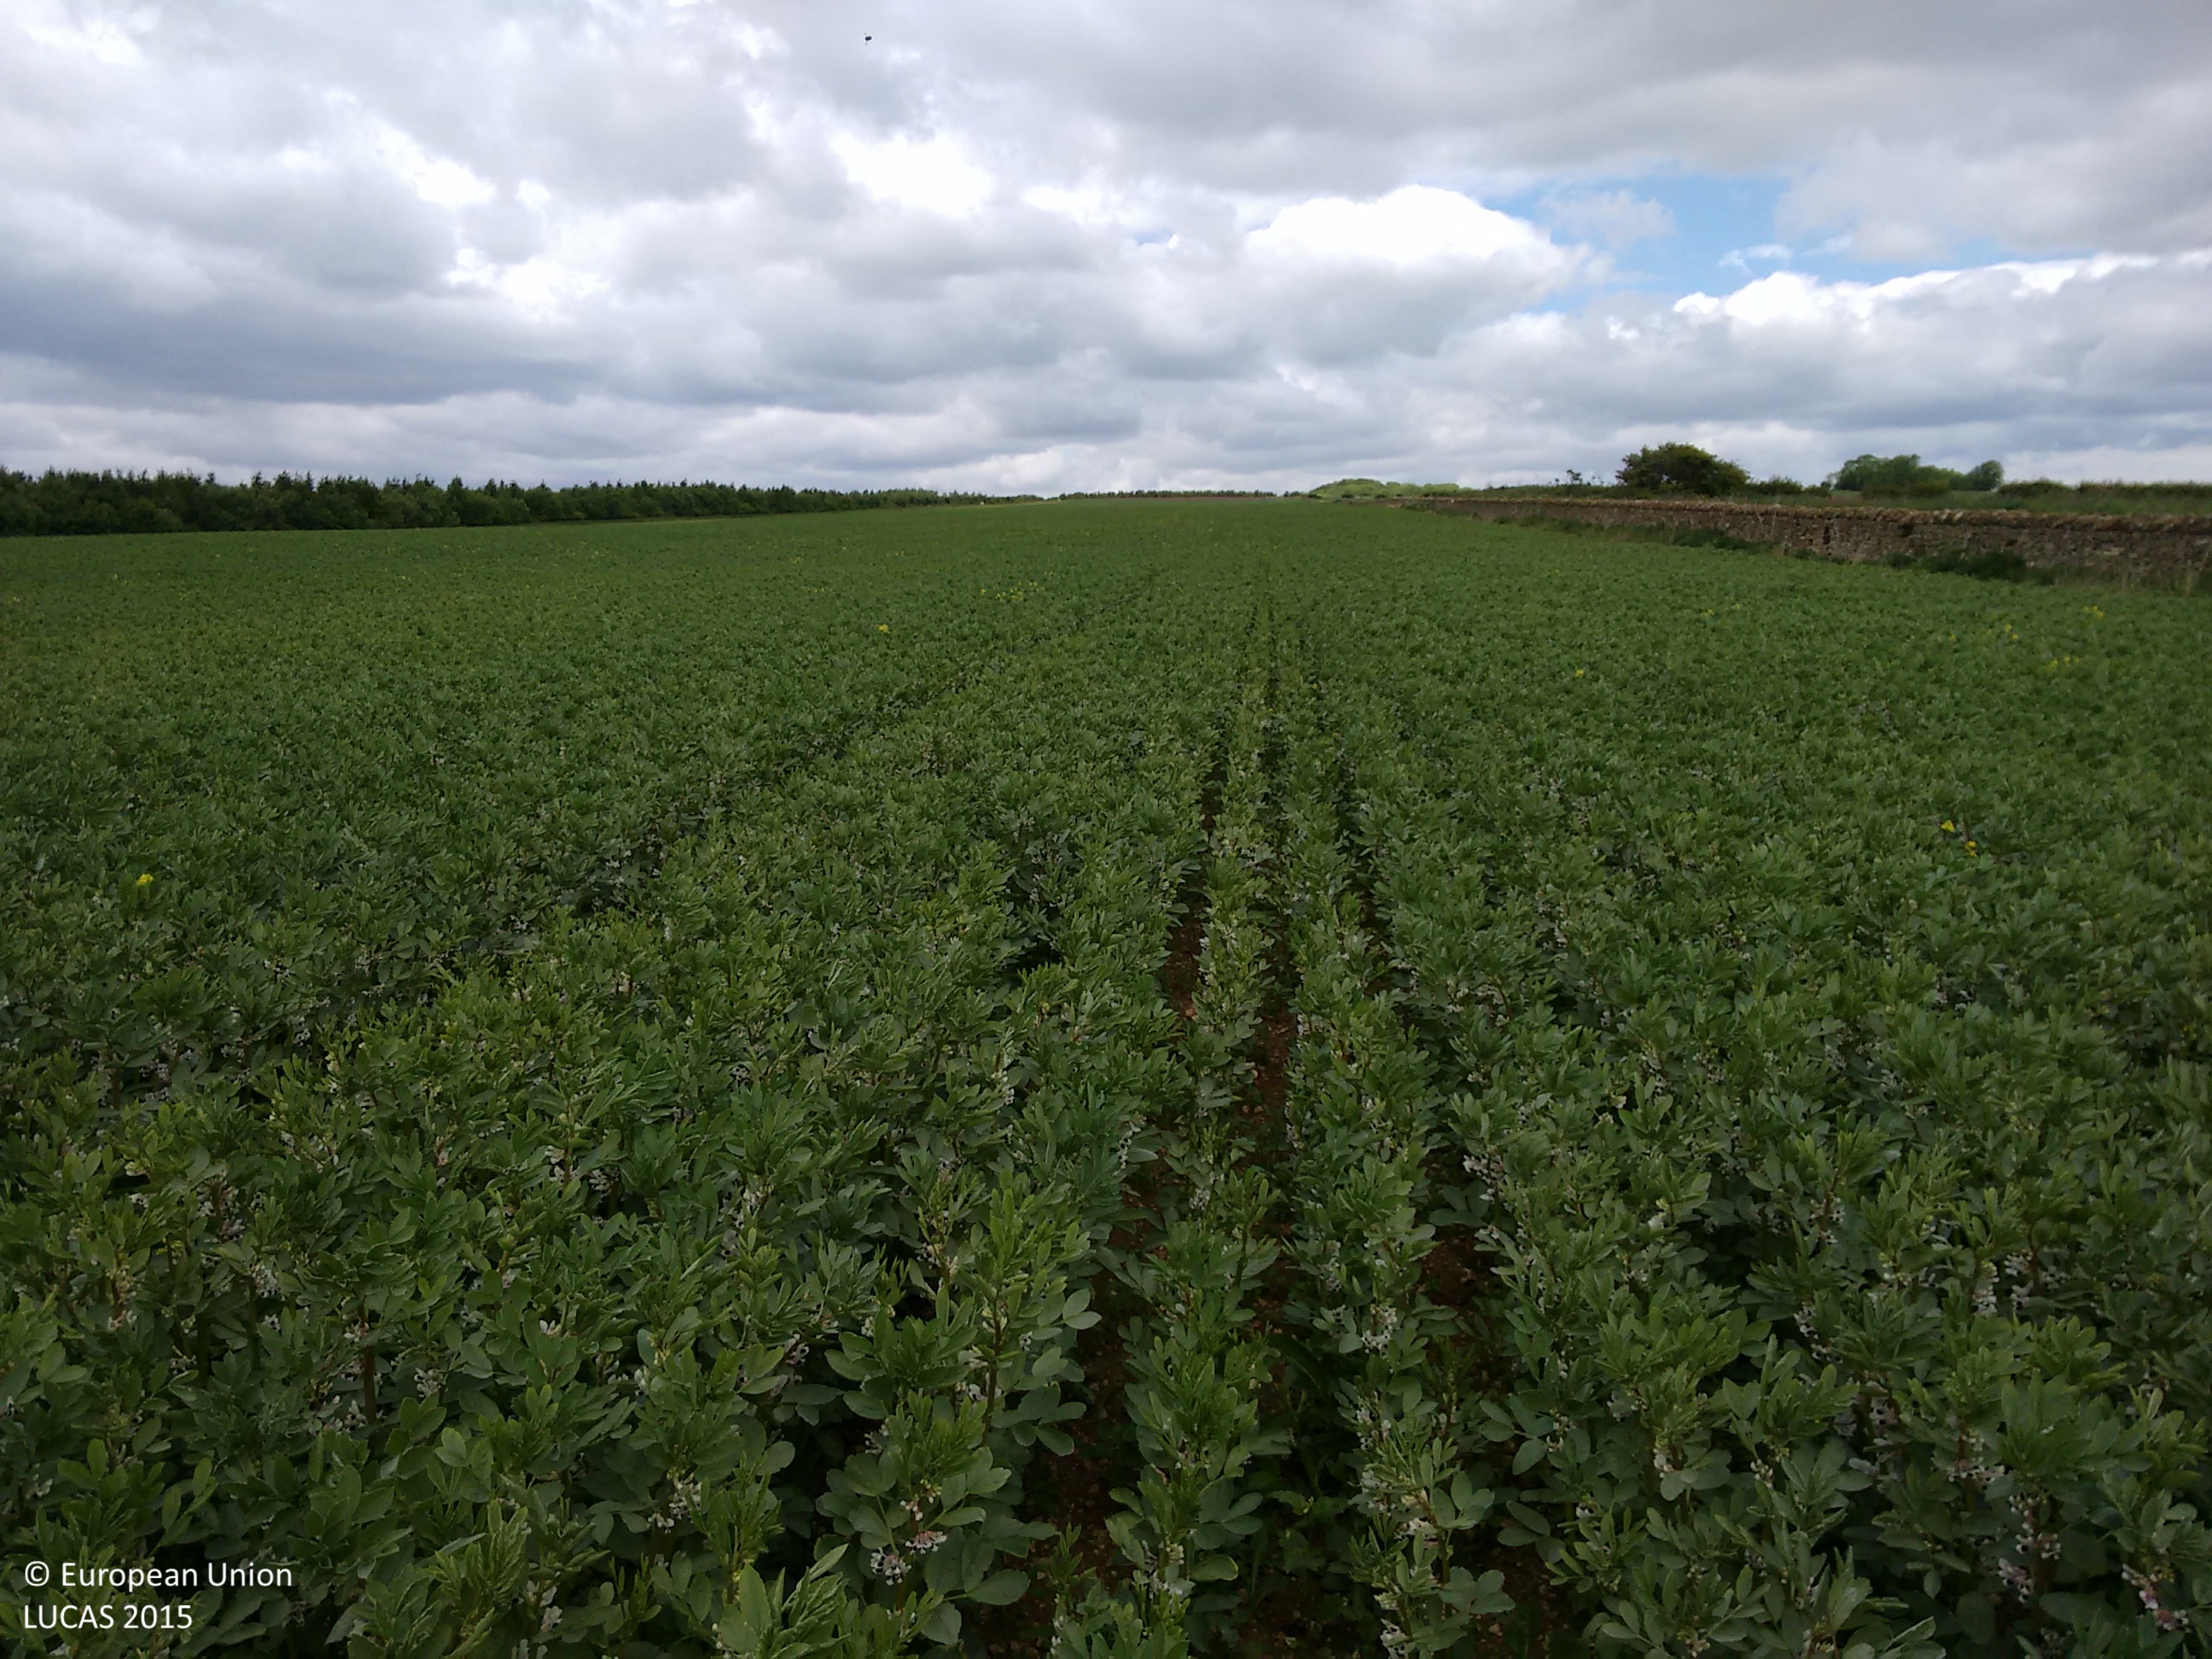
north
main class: Cropland
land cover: Dry pulses
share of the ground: > 75 %
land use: Agriculture (excluding fallow land and kitchen gardens)
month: June
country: GB
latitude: 54.2484
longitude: -0.5185
